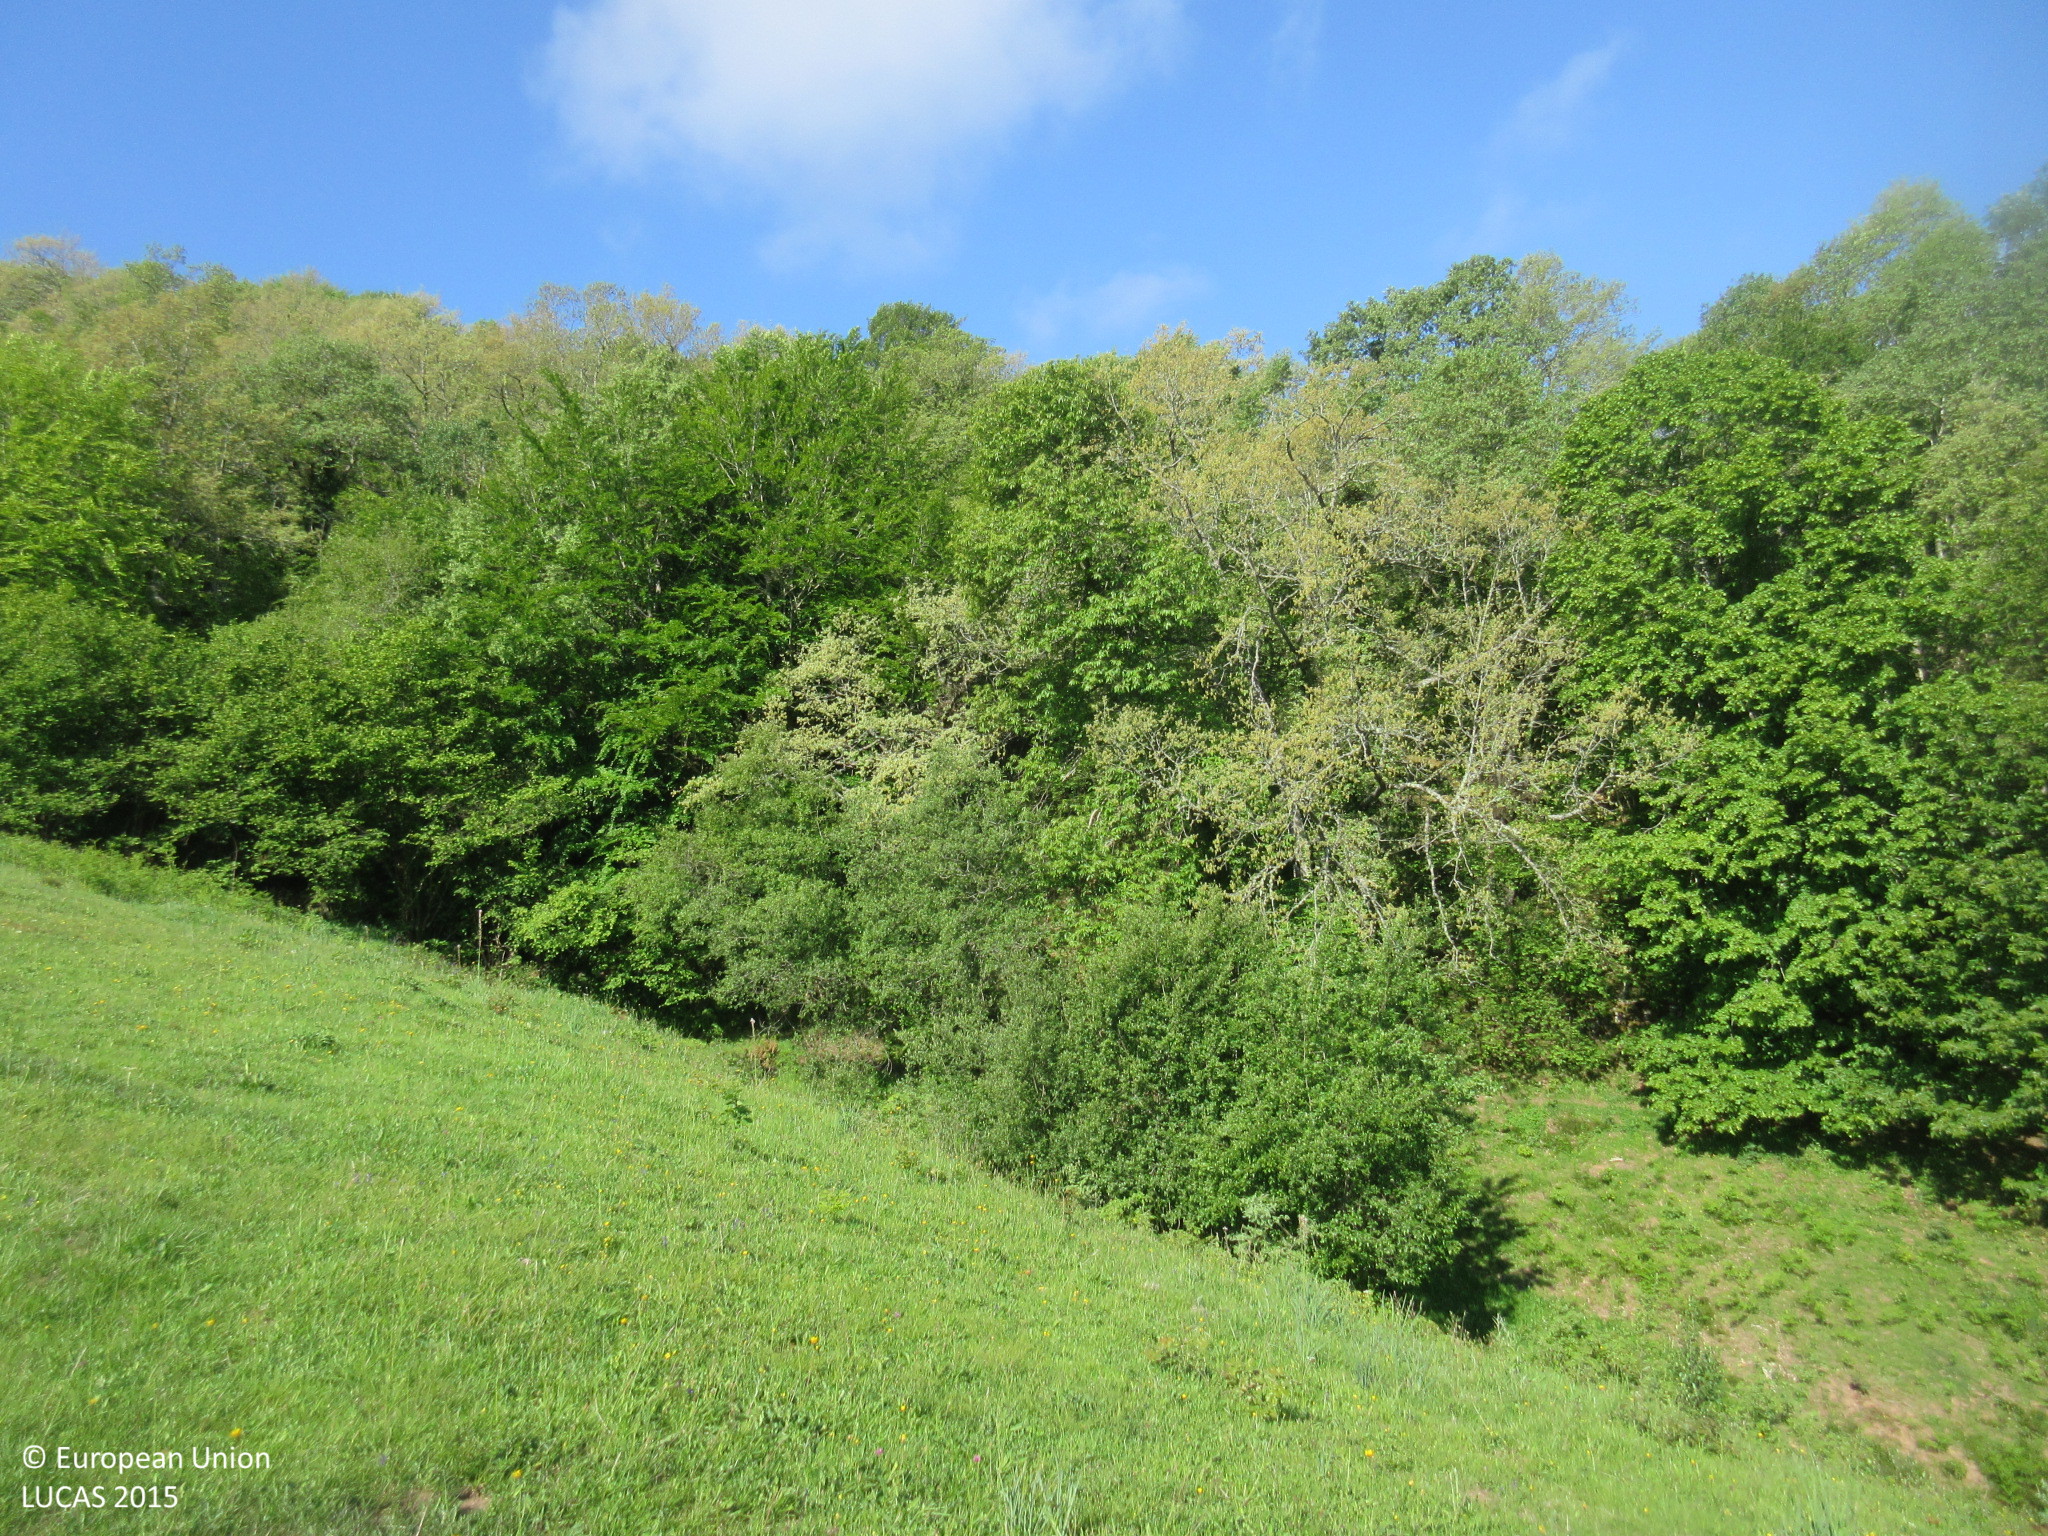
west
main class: Grassland
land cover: Grassland without tree/shrub cover
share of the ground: > 75 %
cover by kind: herbaceous plants 100 %
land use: Agriculture (excluding fallow land and kitchen gardens)
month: May
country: ES
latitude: 43.2269
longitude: -4.5512
